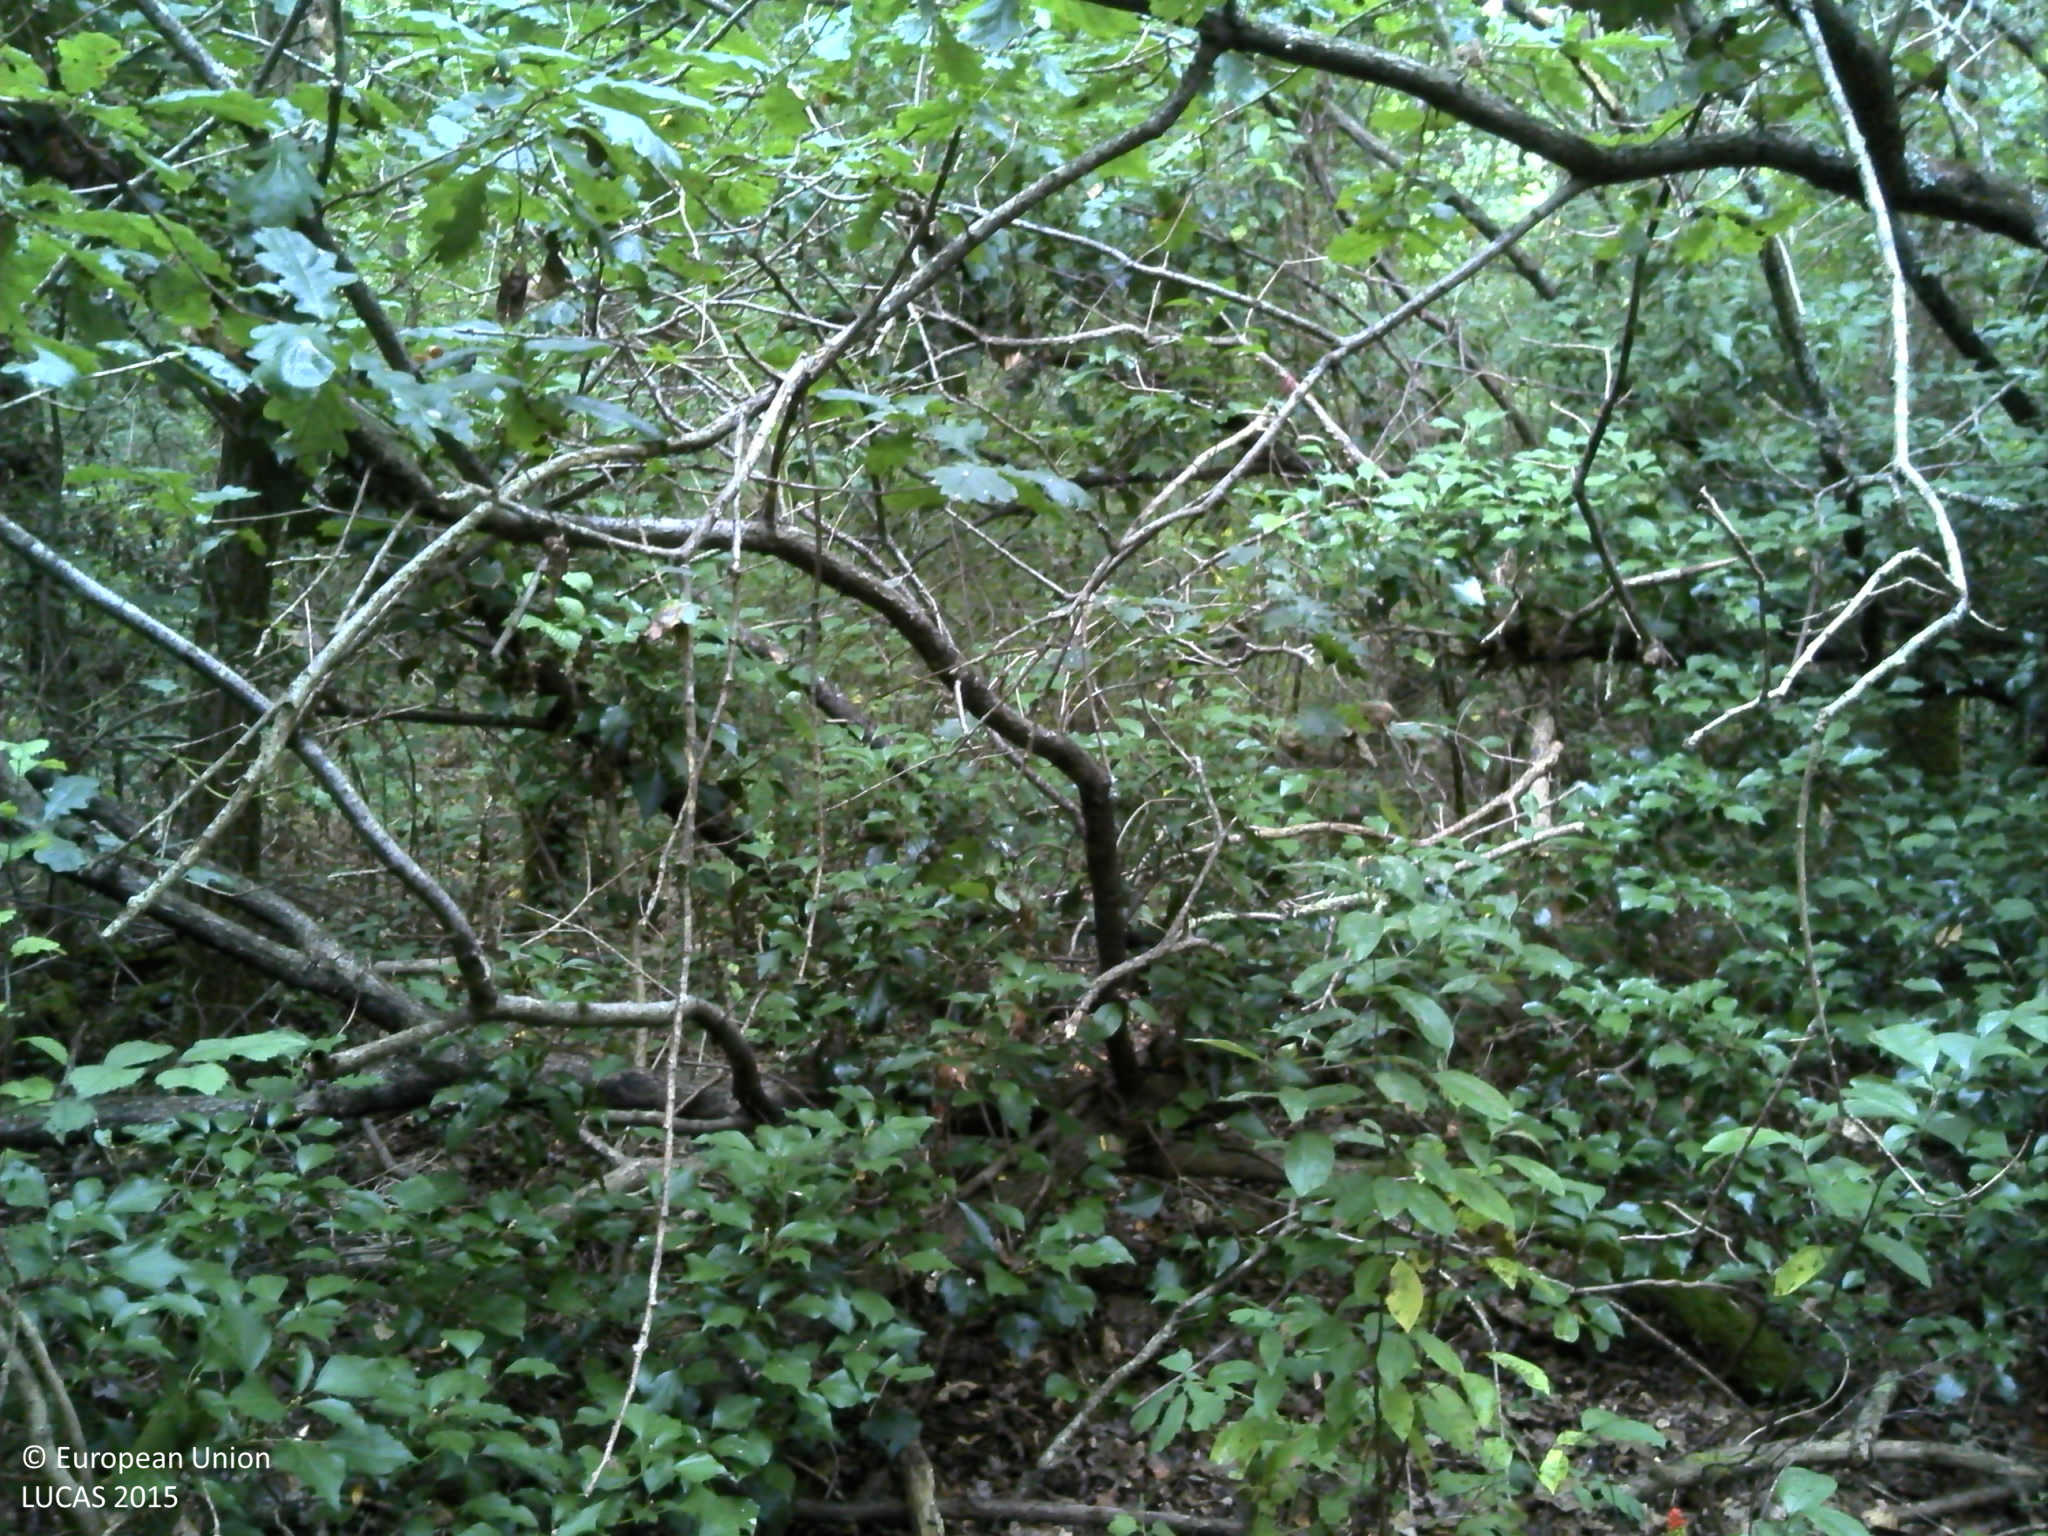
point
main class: Woodland
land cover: Broadleaved woodland
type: acidophilous oak and oak-birch forest
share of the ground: > 75 %
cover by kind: broadleaved forest trees 60 %, shrubs 30 %, herbaceous plants 5 %, lichens and mosses 5 %
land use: Forestry
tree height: > 5 m
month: July
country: FR
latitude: 44.5534
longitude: -0.4007
